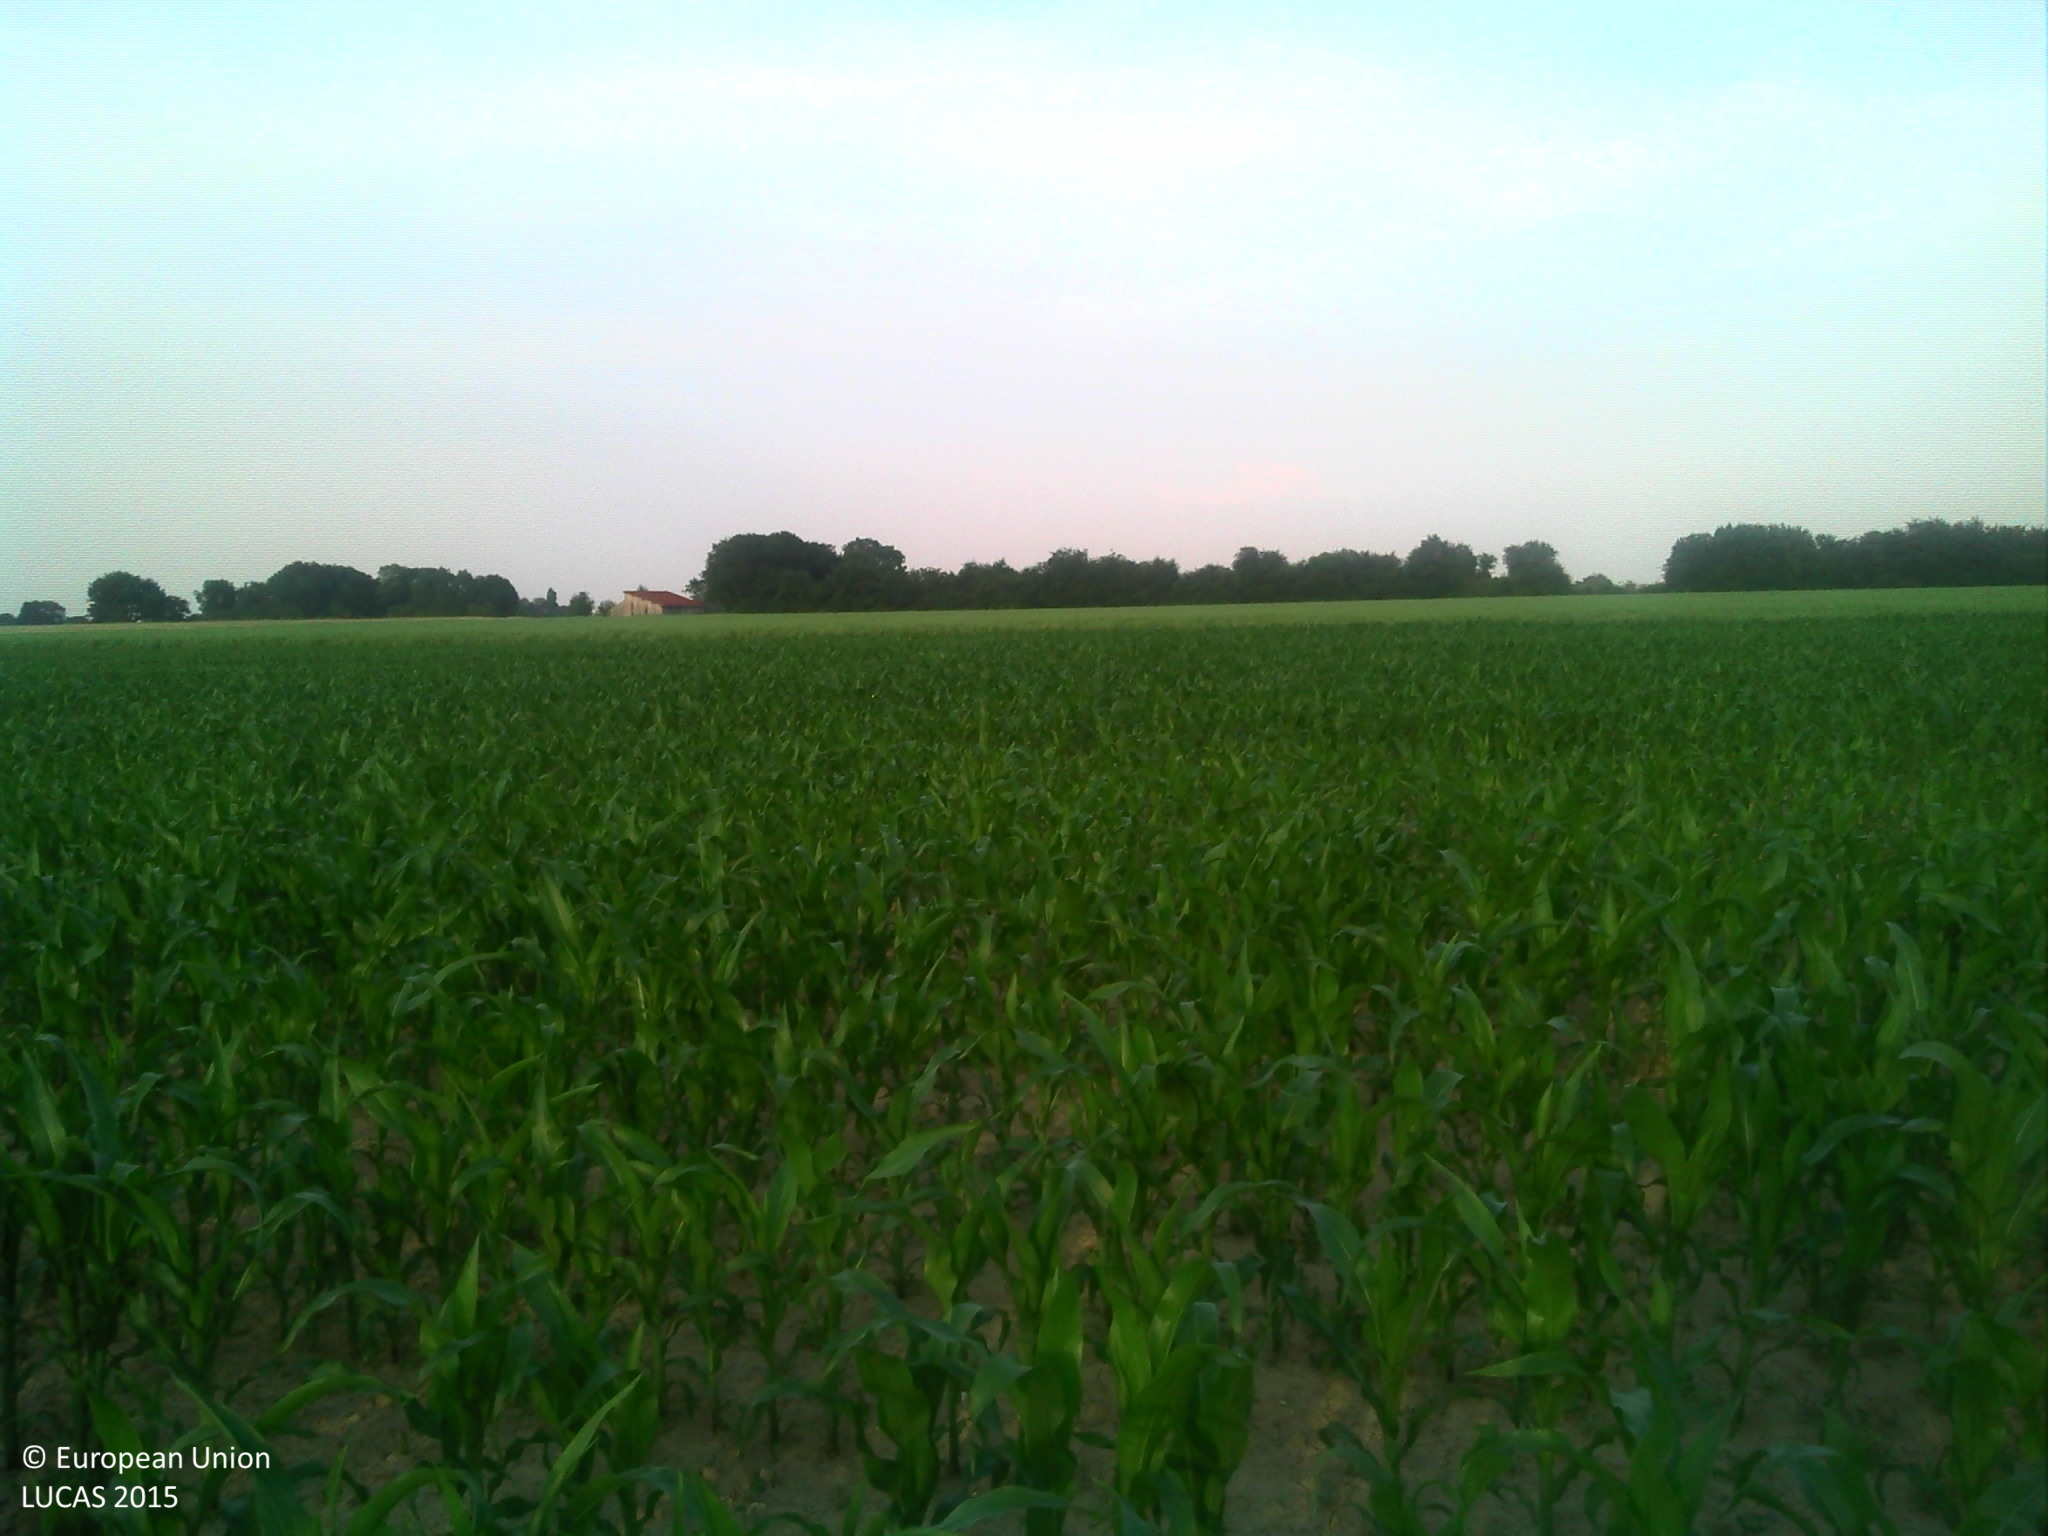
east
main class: Cropland
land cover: Maize
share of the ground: 50 - 75 %
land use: Agriculture (excluding fallow land and kitchen gardens)
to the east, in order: Maize; Dry pulses
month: July
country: FR
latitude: 48.8918
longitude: 0.4124
